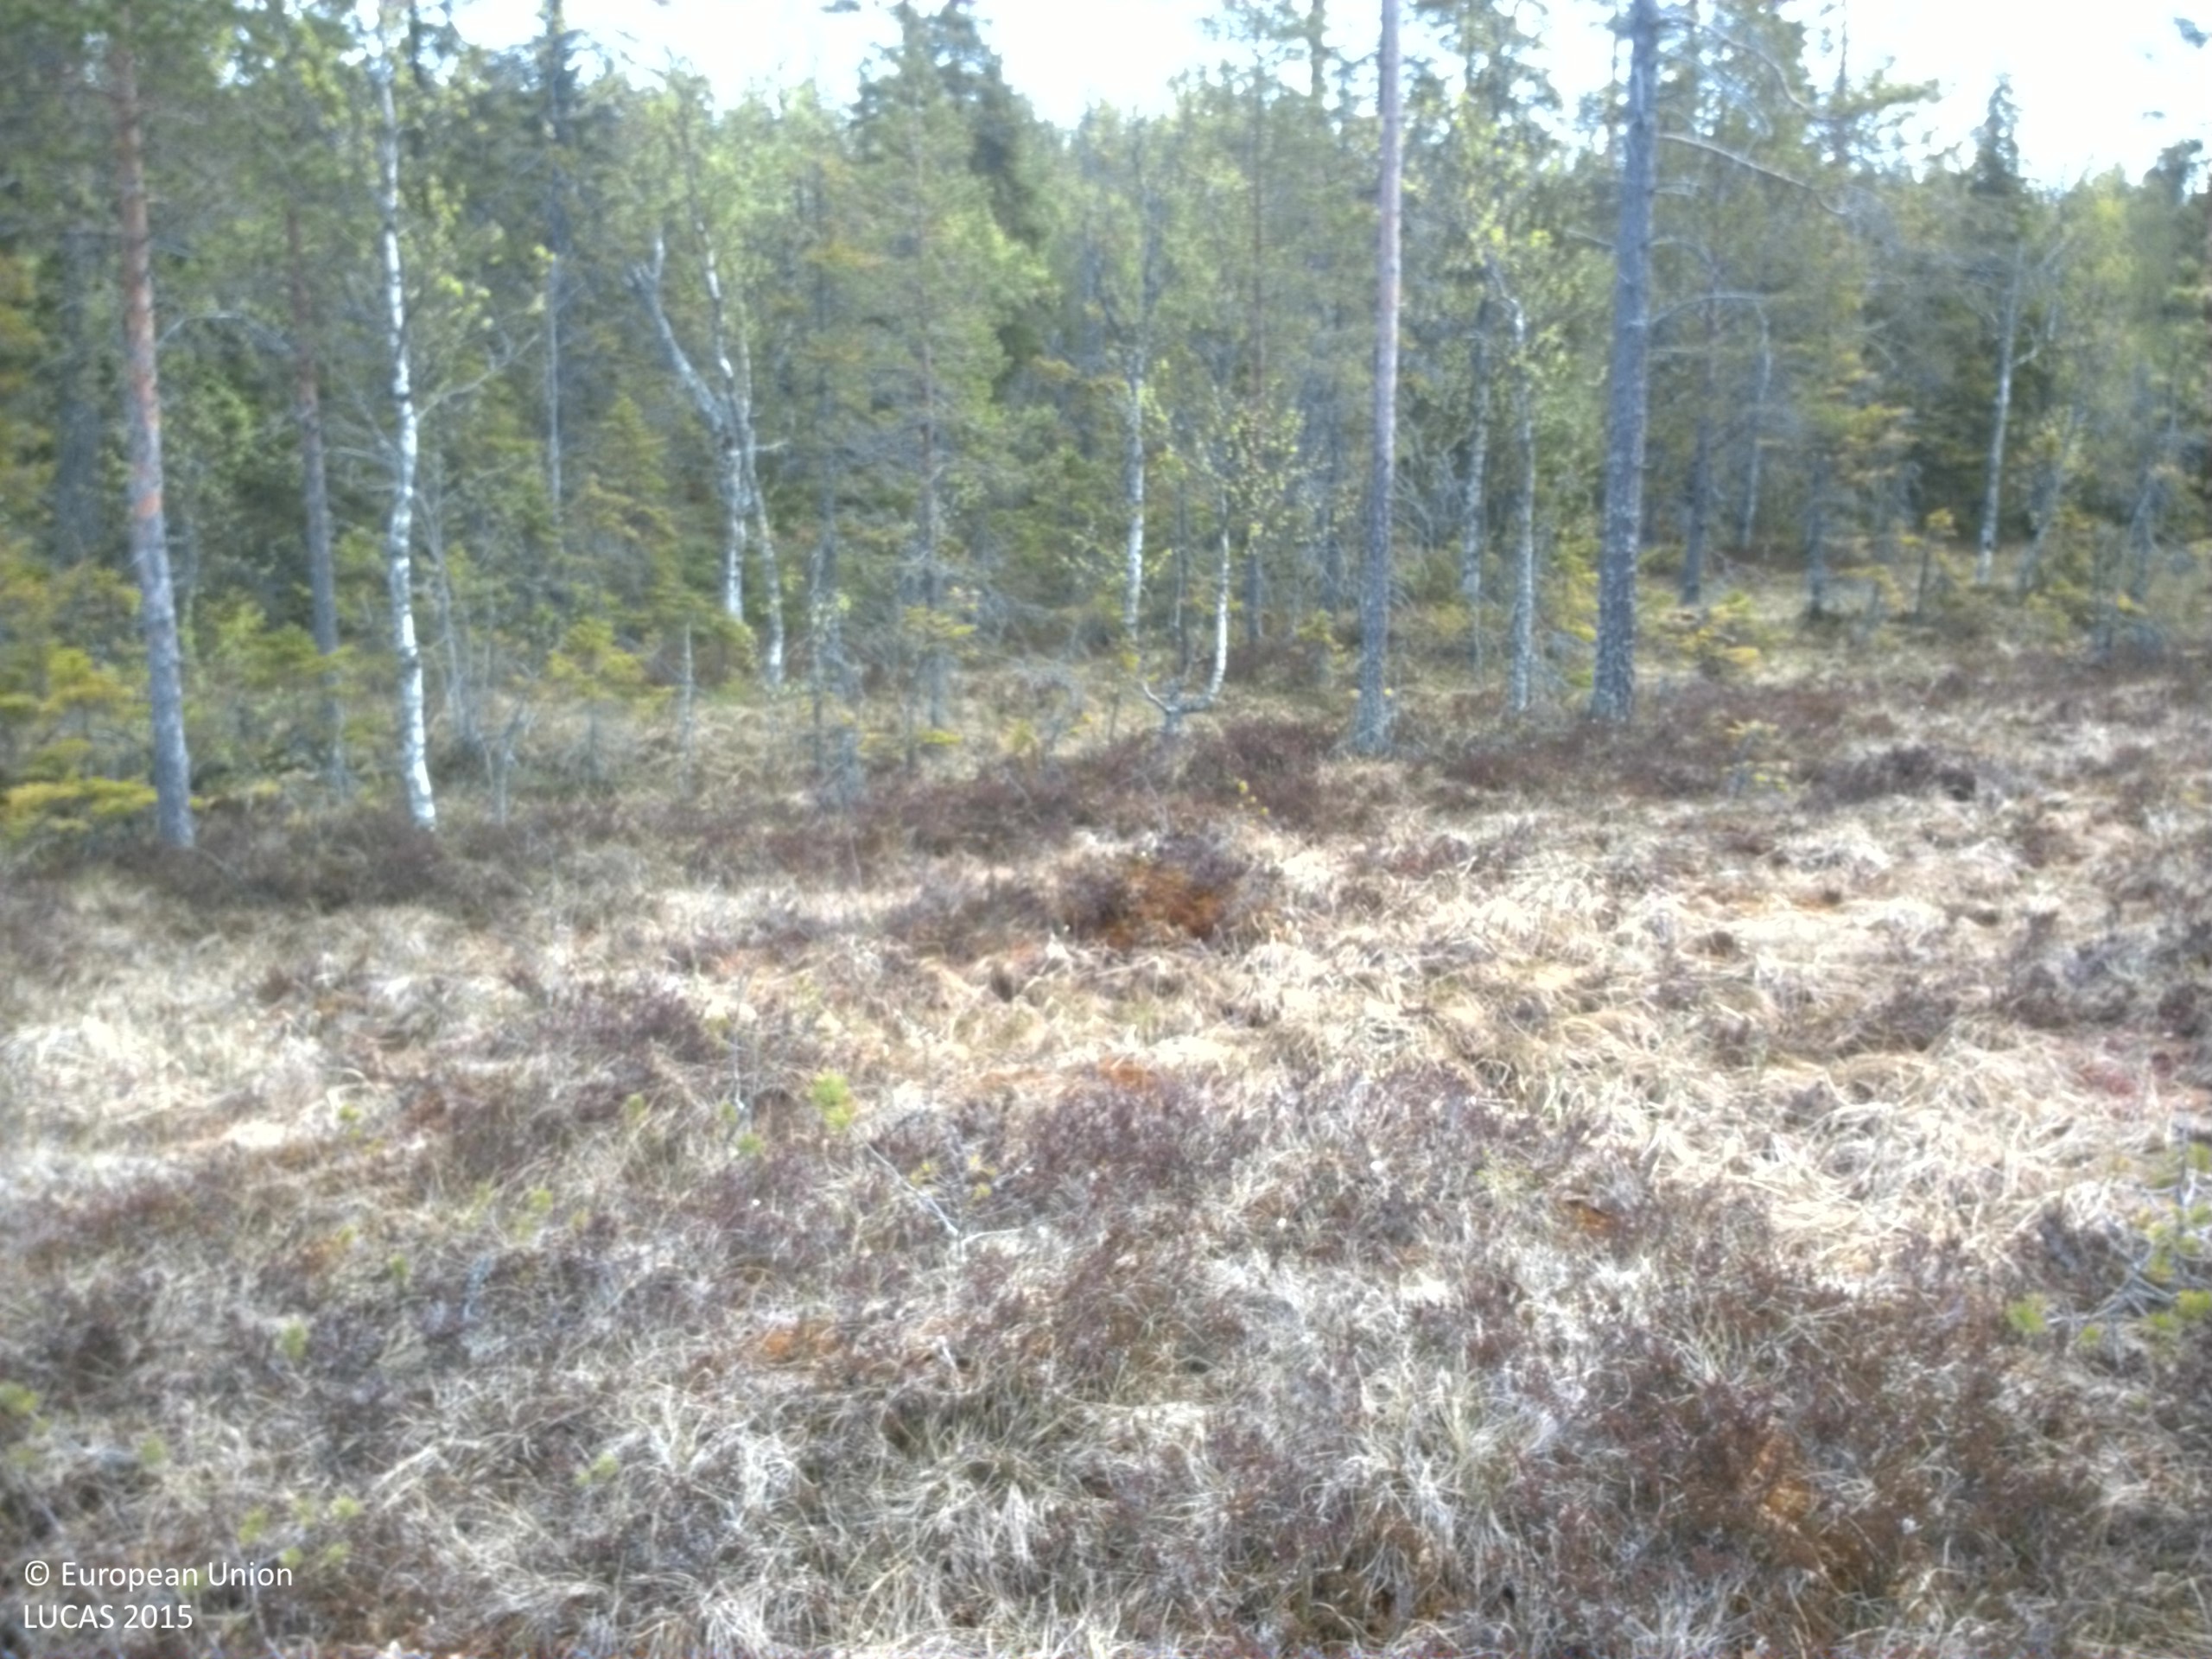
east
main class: Shrubland
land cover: Shrubland with sparse tree cover
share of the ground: 50 - 75 %
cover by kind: shrubs 70 %, herbaceous plants 25 %, coniferous forest trees 5 %
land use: Semi-natural and natural areas not in use
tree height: > 5 m
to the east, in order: Shrubland with sparse tree cover; Ditches and canals; Pine dominated coniferous woodland
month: June
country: SE
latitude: 62.9147
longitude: 17.1233
